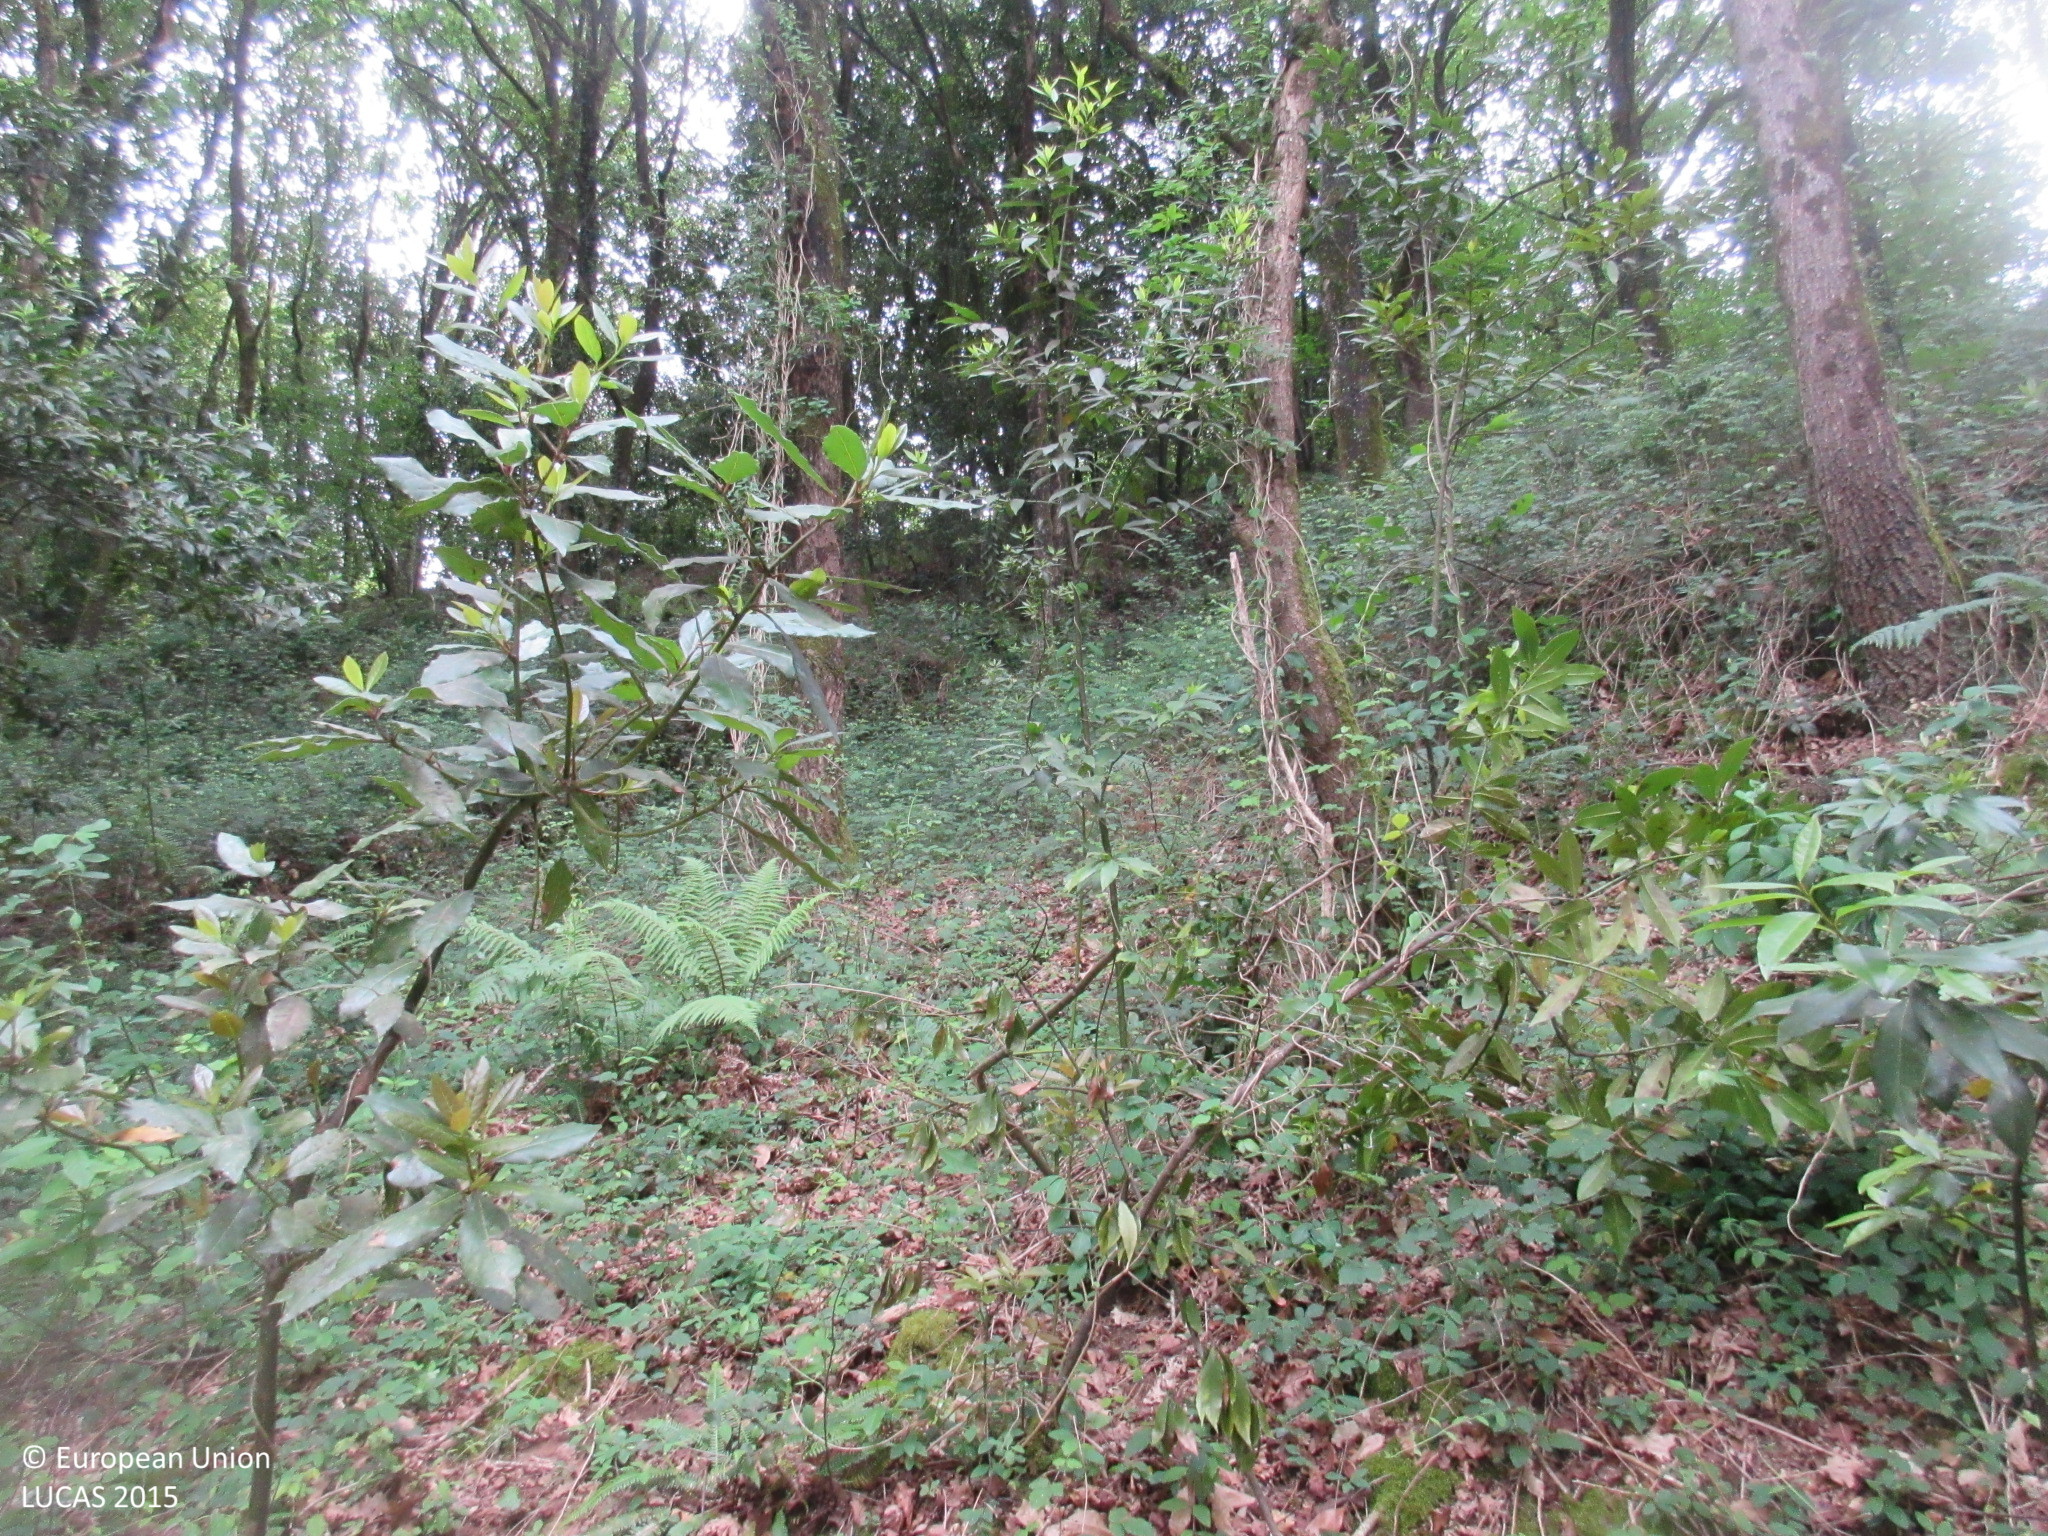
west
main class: Woodland
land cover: Broadleaved woodland
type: thermophilous deciduous forest
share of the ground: > 75 %
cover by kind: broadleaved forest trees 95 %, shrubs 5 %
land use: Forestry
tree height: > 5 m
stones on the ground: < 10 %
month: June
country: ES
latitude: 43.3456
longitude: -3.4267
